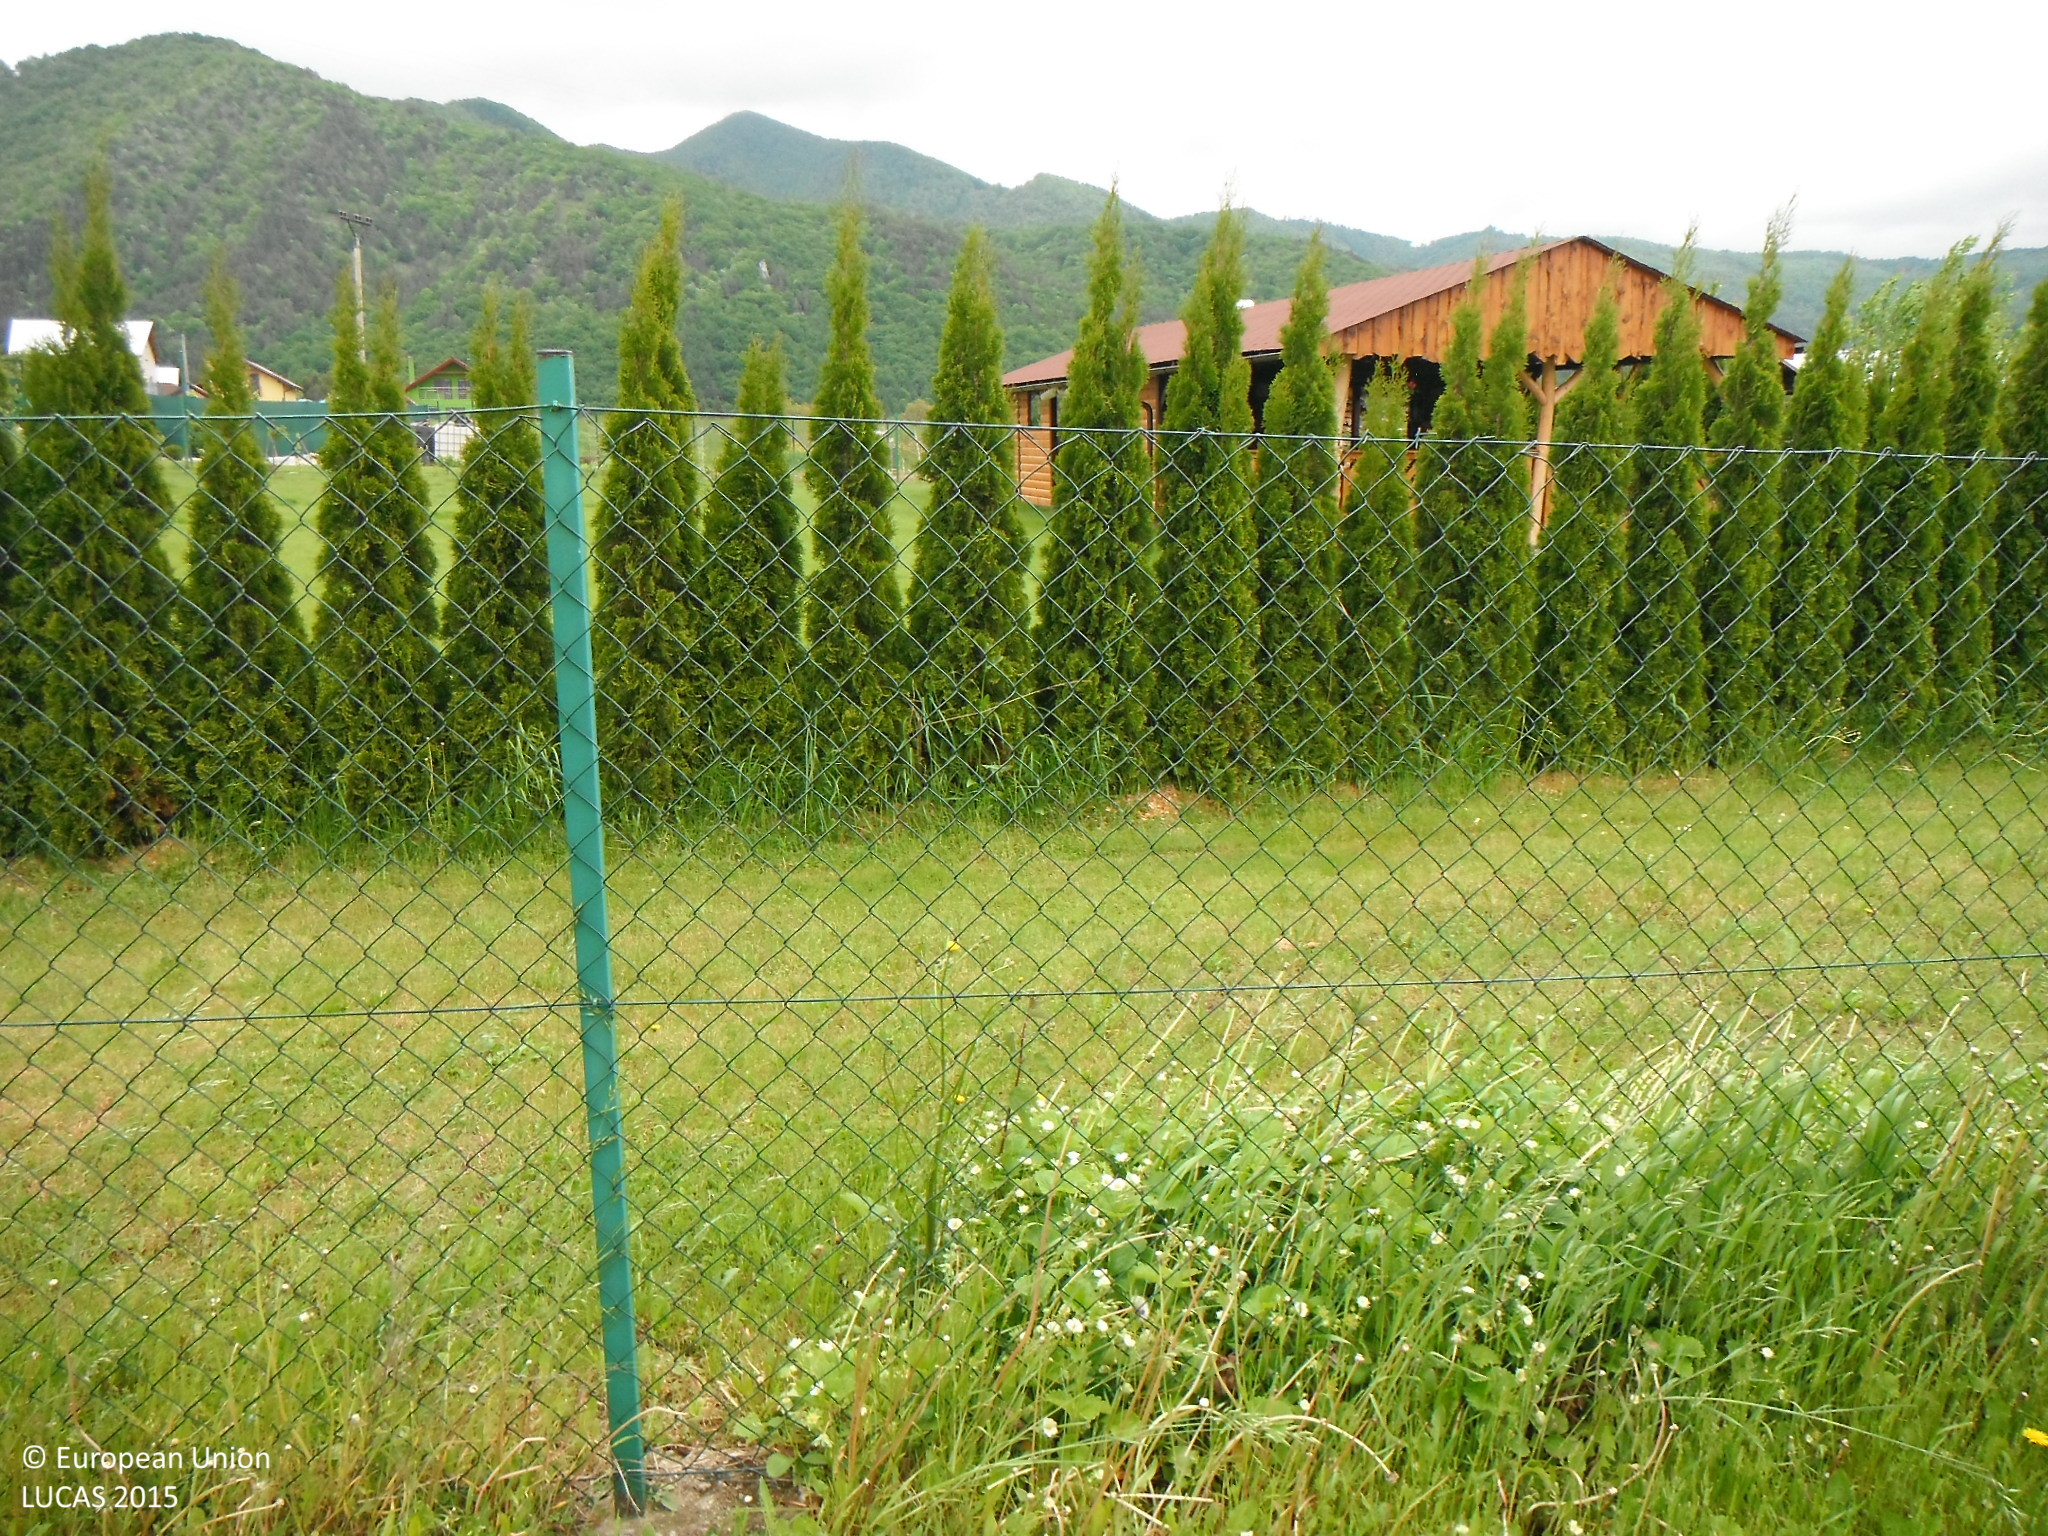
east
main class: Grassland
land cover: Grassland without tree/shrub cover
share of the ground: > 75 %
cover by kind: herbaceous plants 100 %
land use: Residential
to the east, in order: Grassland without tree/shrub cover; Artificial constructions in urban areas; Common wheat; Electric lines; Common wheat; Potatoes; Electric lines; Potatoes; Grass margins; Tracks; Grass margins; Common wheat; Grass margins; Common wheat; Potatoes
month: May
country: SK
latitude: 49.1334
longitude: 19.0819
